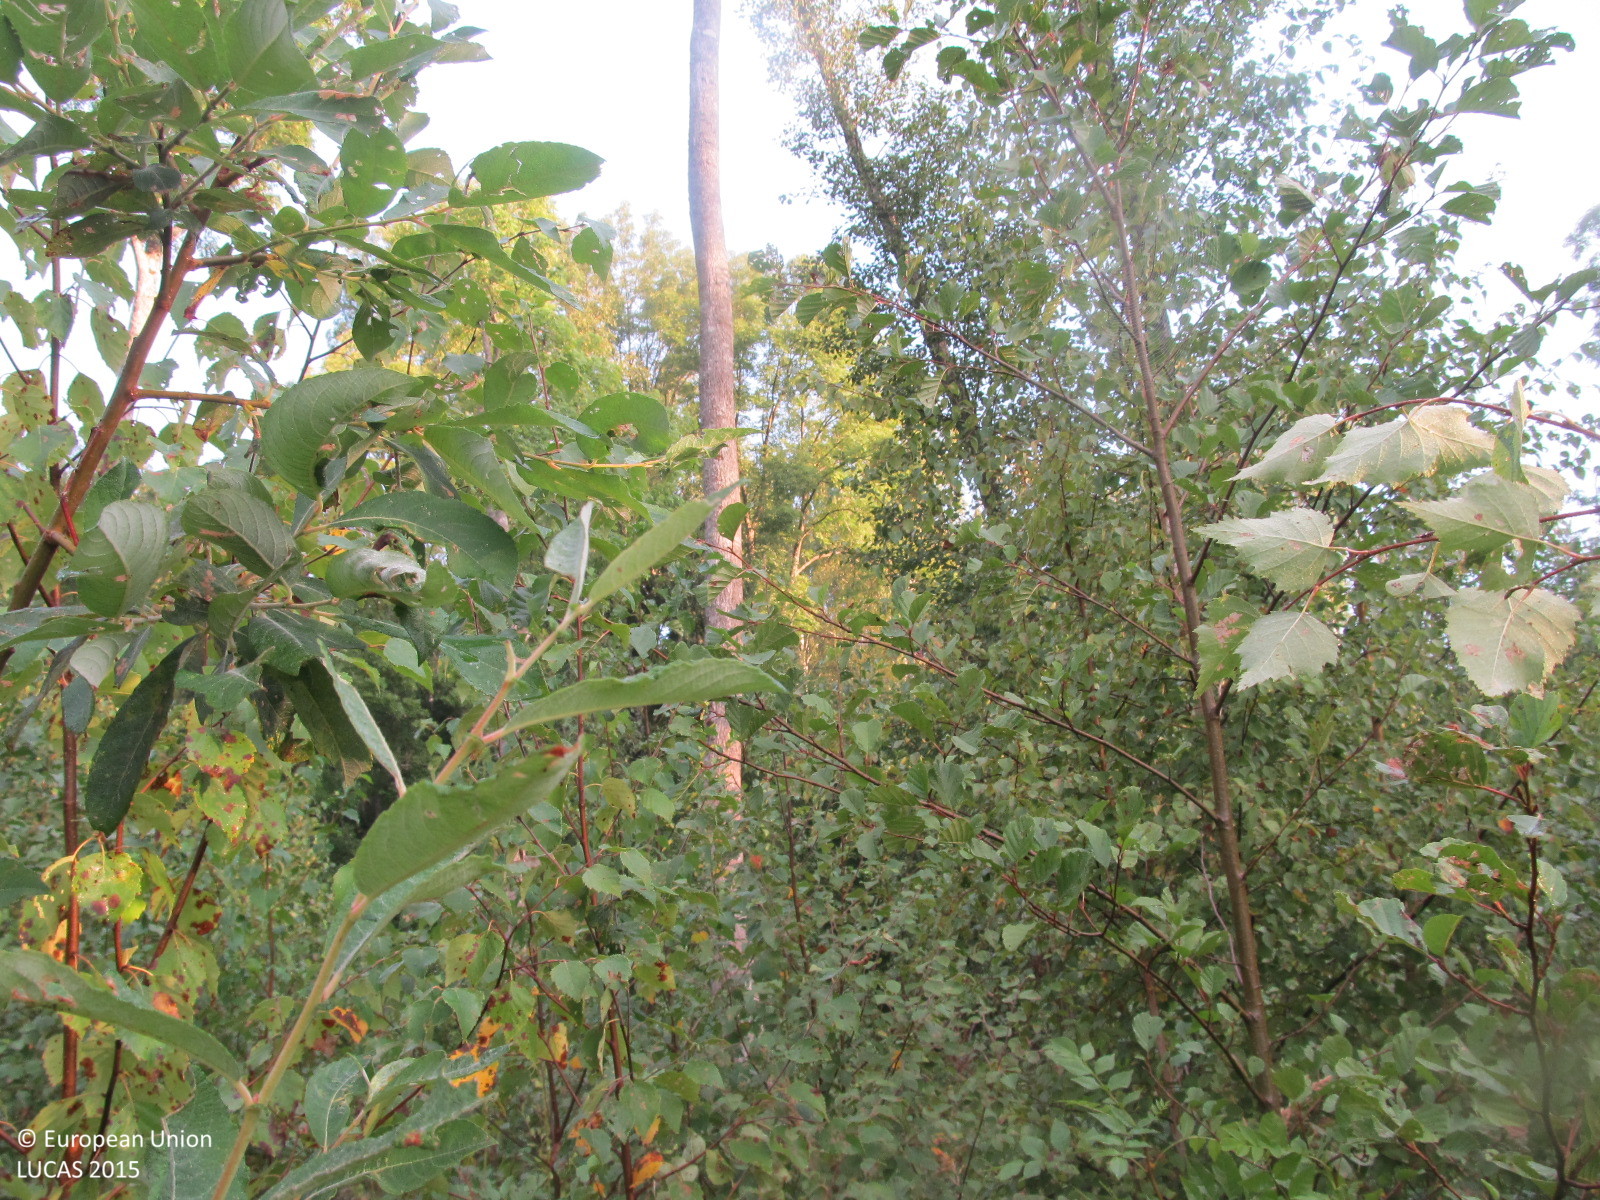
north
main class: Woodland
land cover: Broadleaved woodland
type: non-riverine alder, birch or aspen forest
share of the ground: > 75 %
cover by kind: broadleaved forest trees 75 %, shrubs 10 %, herbaceous plants 10 %, coniferous forest trees 5 %
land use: Forestry
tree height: < 5 m
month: September
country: LT
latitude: 56.0516
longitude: 23.3526
